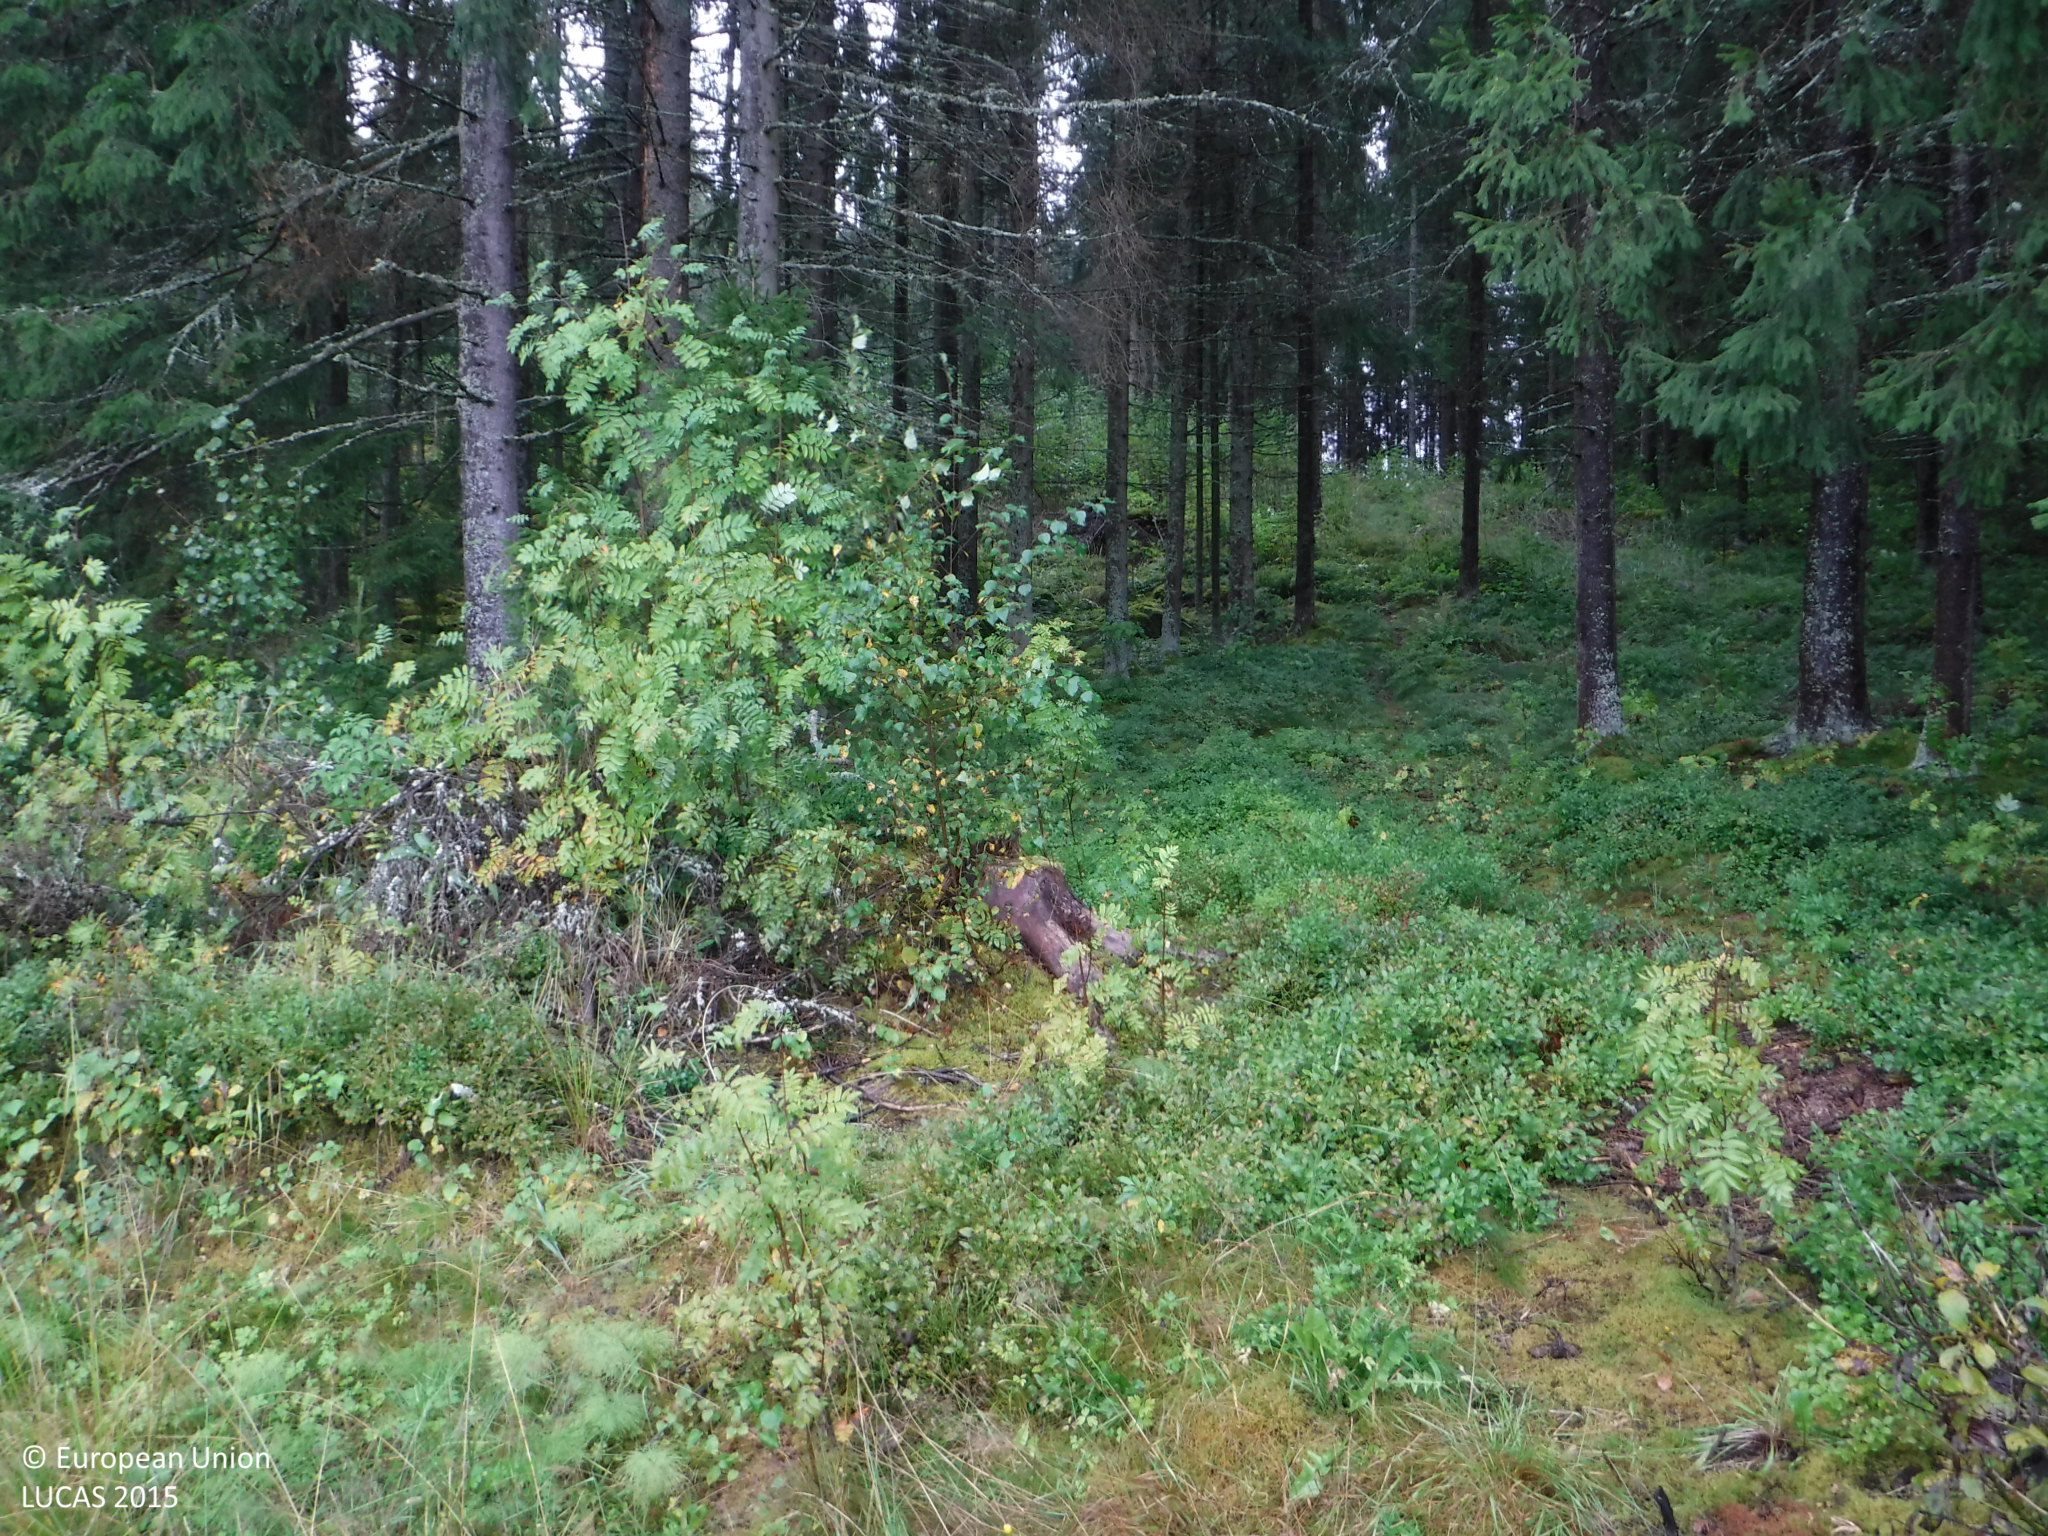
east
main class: Cropland
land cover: Common wheat
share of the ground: > 75 %
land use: Agriculture (excluding fallow land and kitchen gardens)
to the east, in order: Grass margins; Ditches and canals; Shruby margins; Spruce dominated coniferous woodland; Spruce dominated mixed woodland; Spruce dominated coniferous woodland; Artificial constructions in urban areas; Spruce dominated coniferous woodland; Other mixed woodland; Spruce dominated coniferous woodland
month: September
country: FI
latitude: 61.3298
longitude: 23.0212
